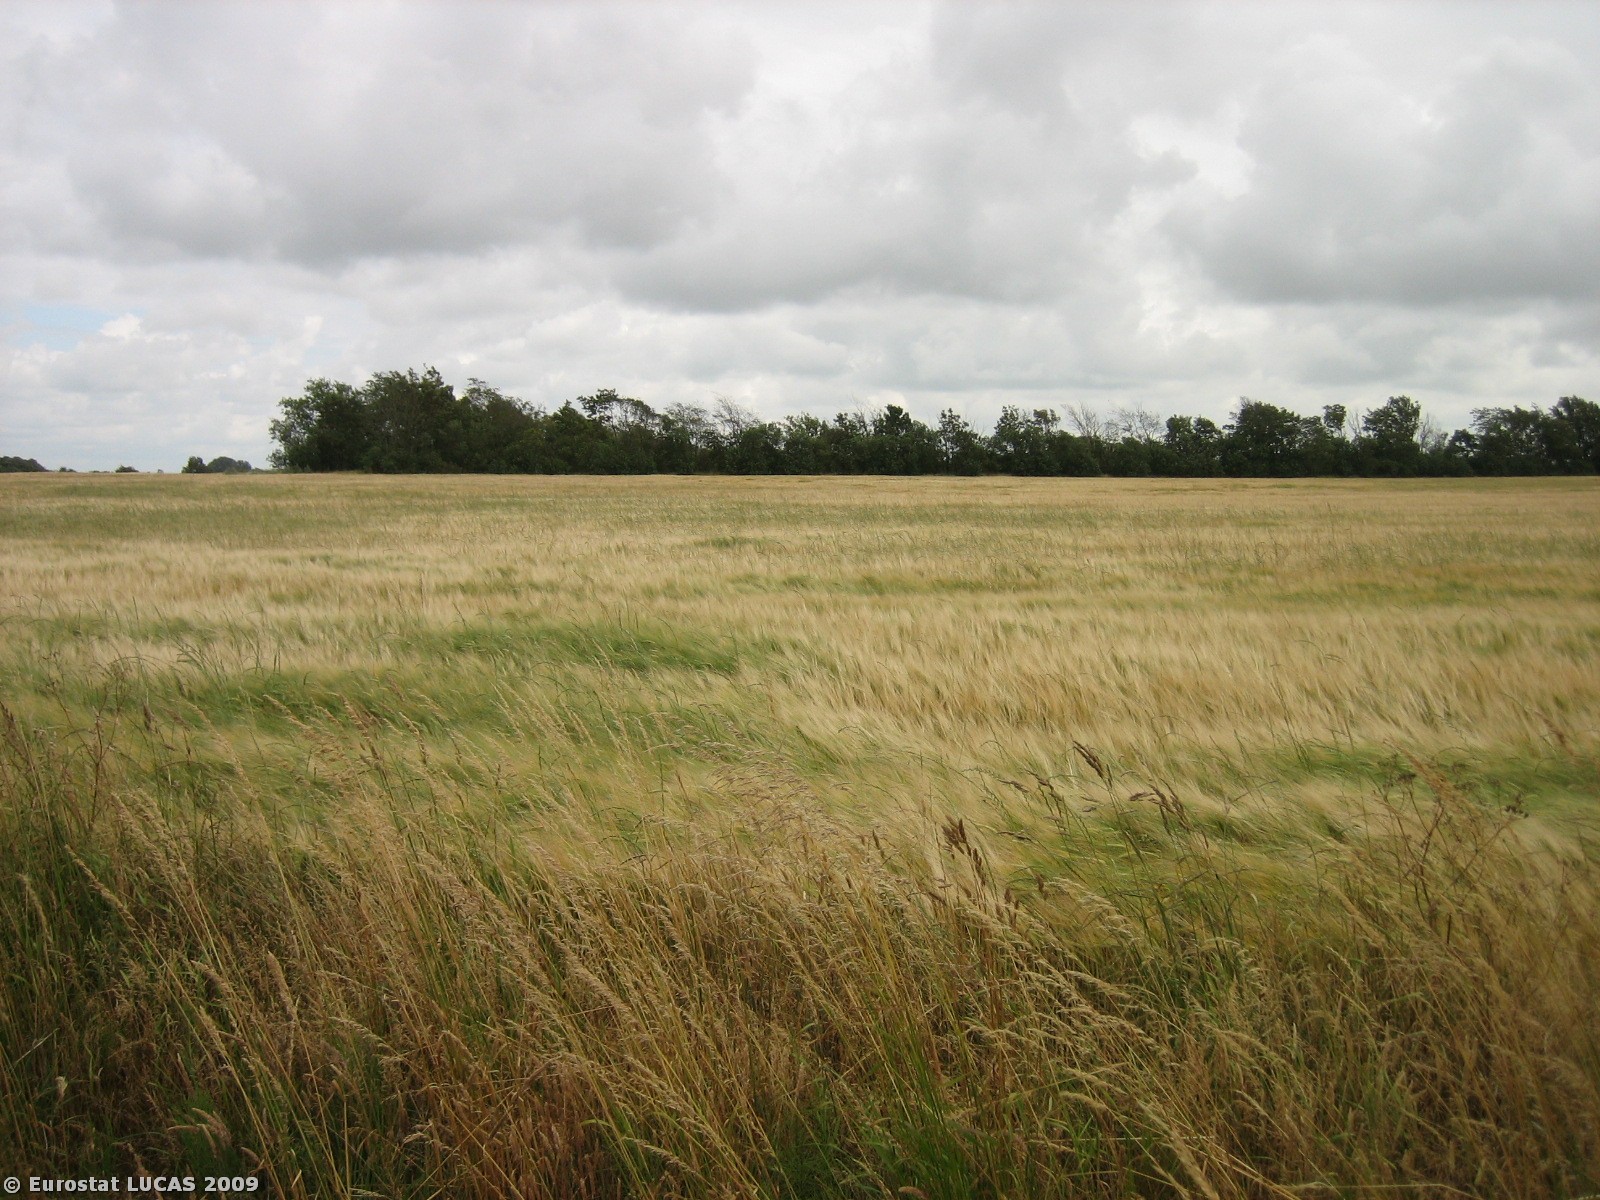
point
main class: Cropland
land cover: Barley
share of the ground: > 75 %
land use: Agriculture (excluding fallow land and kitchen gardens)
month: July
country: DK
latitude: 55.8559
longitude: 8.5477
